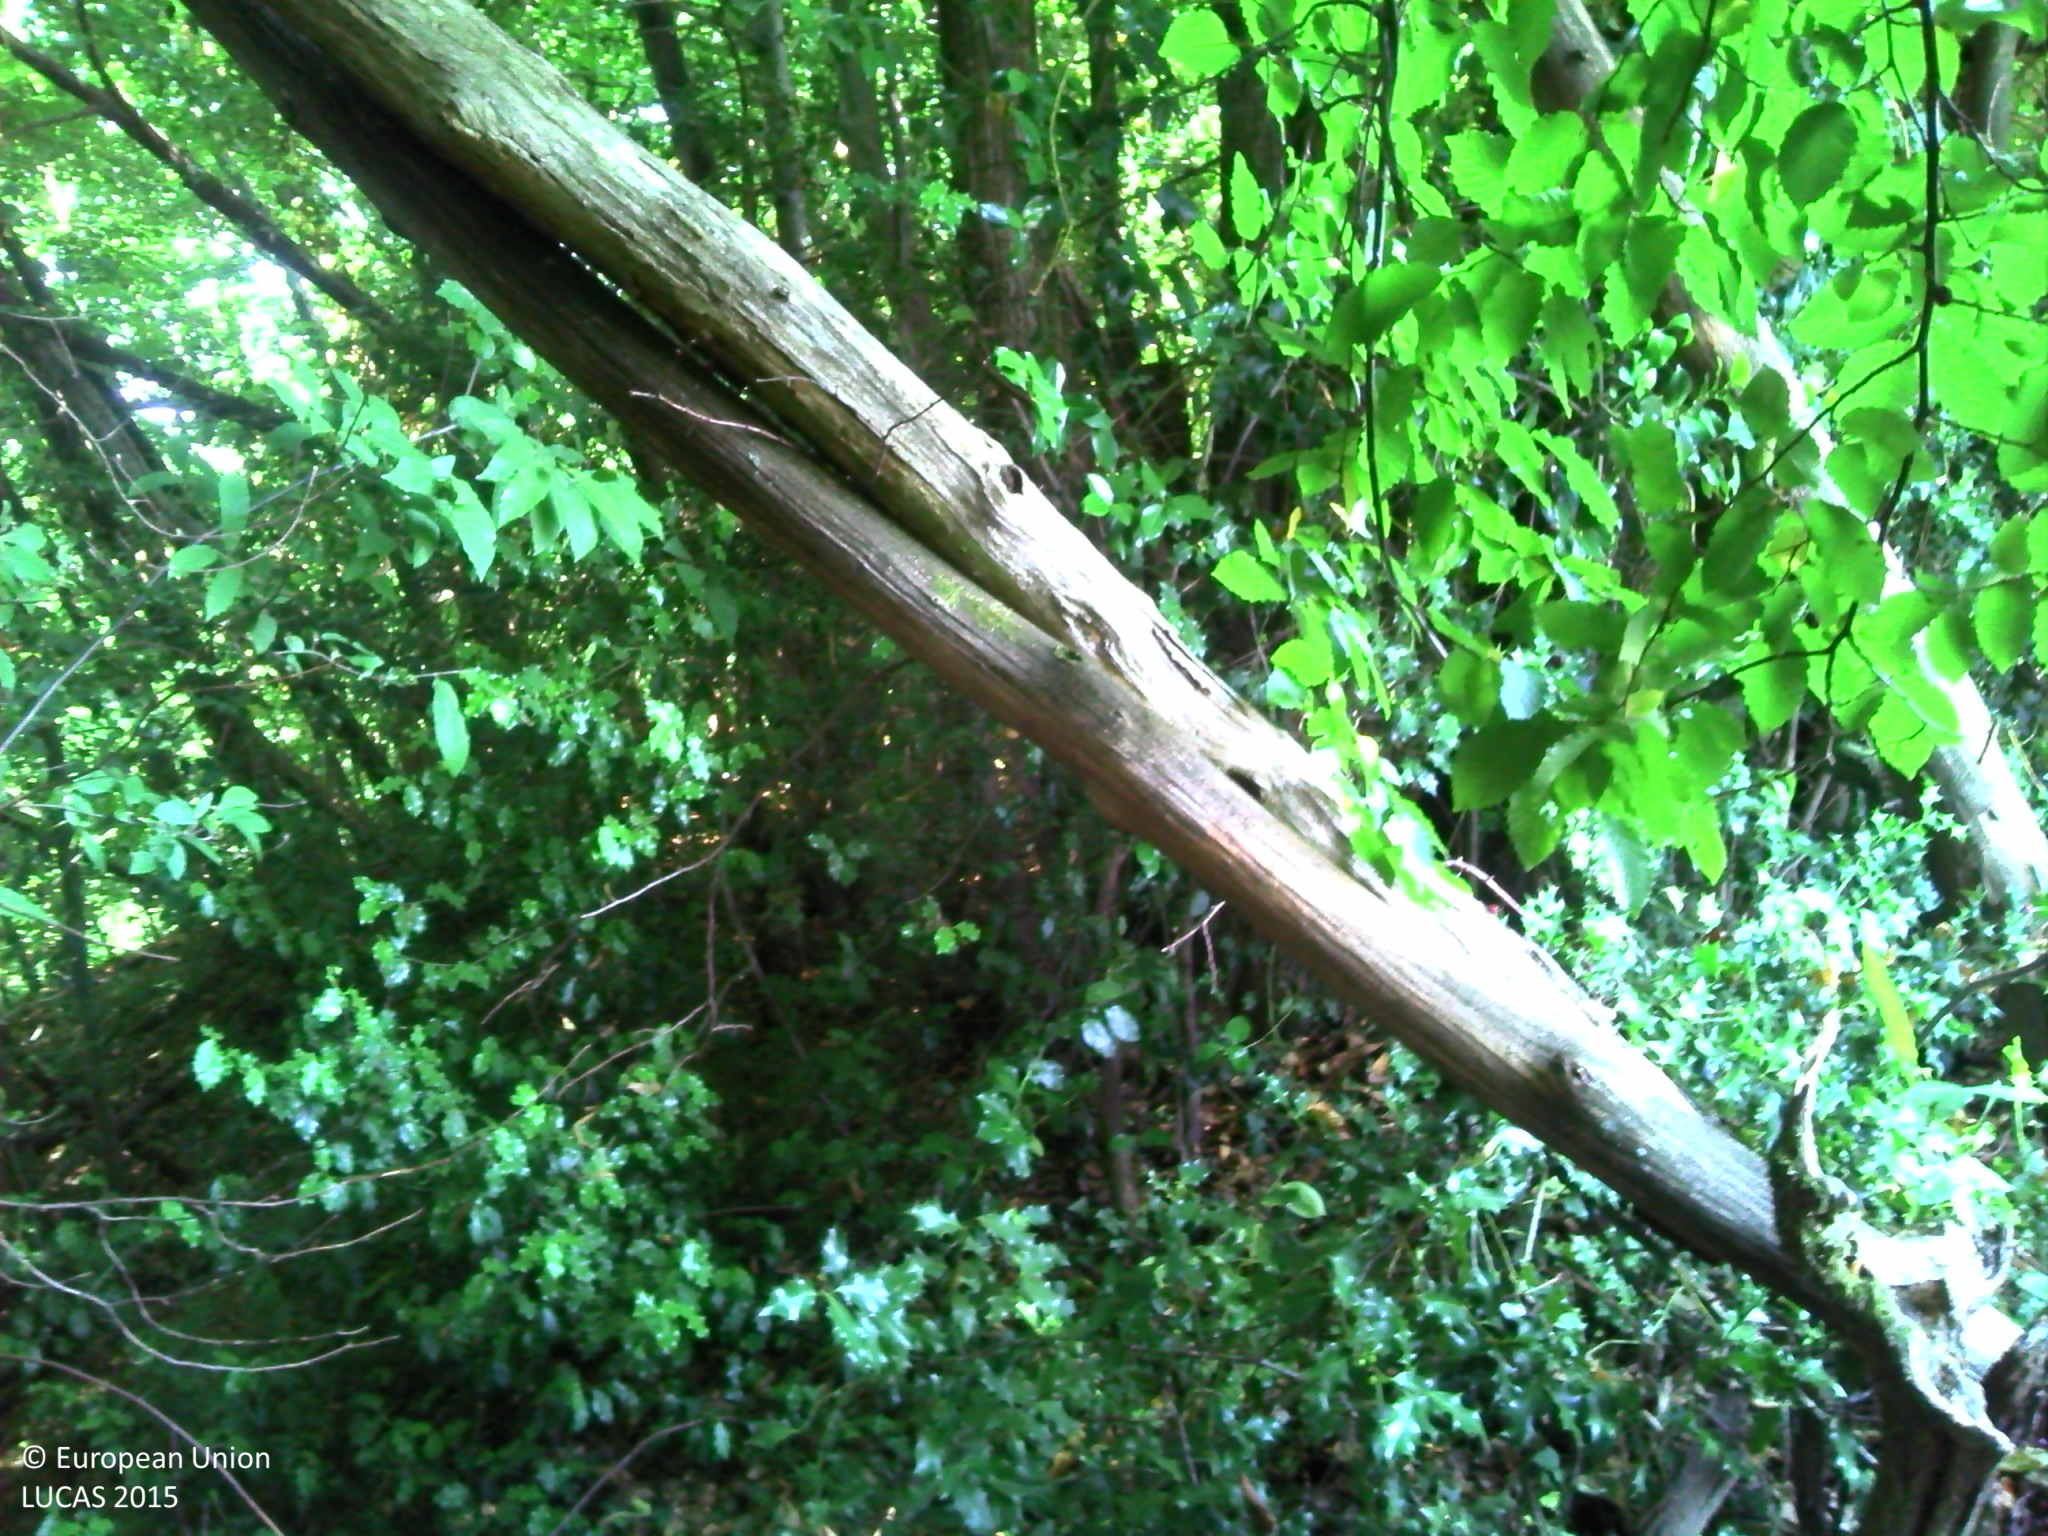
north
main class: Woodland
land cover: Broadleaved woodland
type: thermophilous deciduous forest
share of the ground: > 75 %
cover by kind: broadleaved forest trees 90 %, herbaceous plants 10 %
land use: Semi-natural and natural areas not in use
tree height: > 5 m
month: July
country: FR
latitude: 45.3733
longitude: 5.1142
